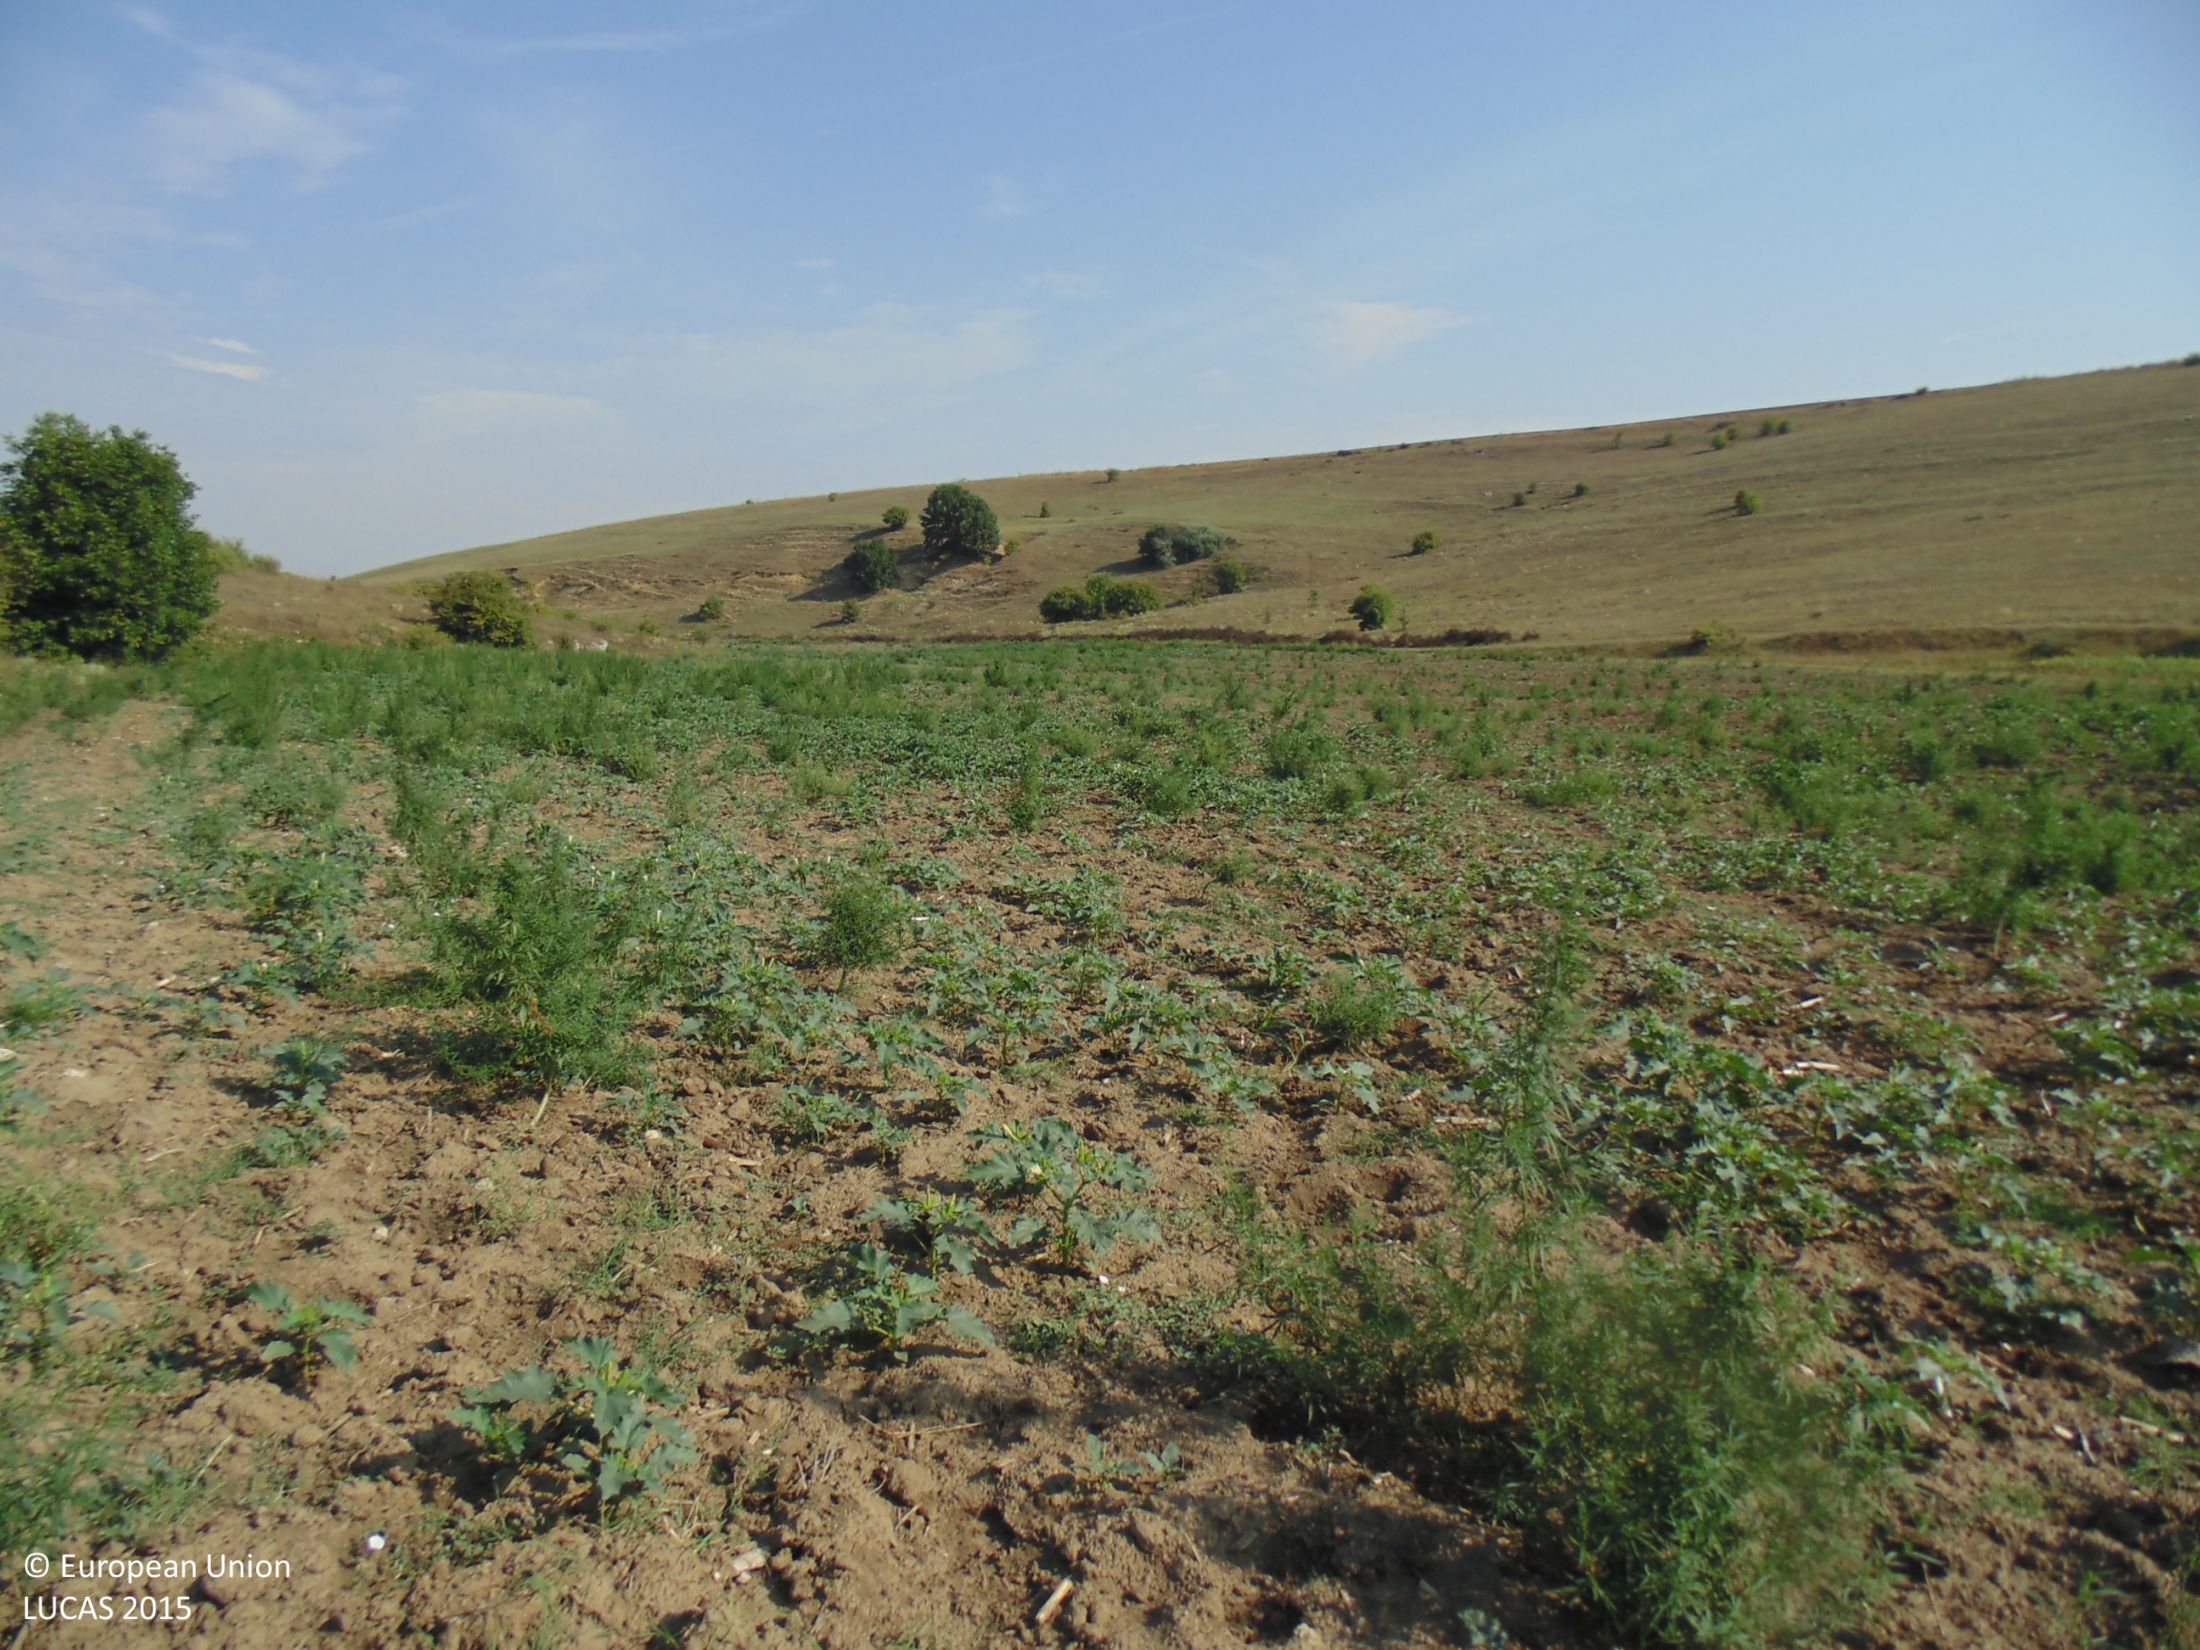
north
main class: Grassland
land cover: Spontaneously vegetated surfaces
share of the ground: 50 - 75 %
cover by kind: herbaceous plants 70 %, unconsolidated bare surface 30 %
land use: Fallow land
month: August
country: BG
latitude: 43.8740
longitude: 27.7520
